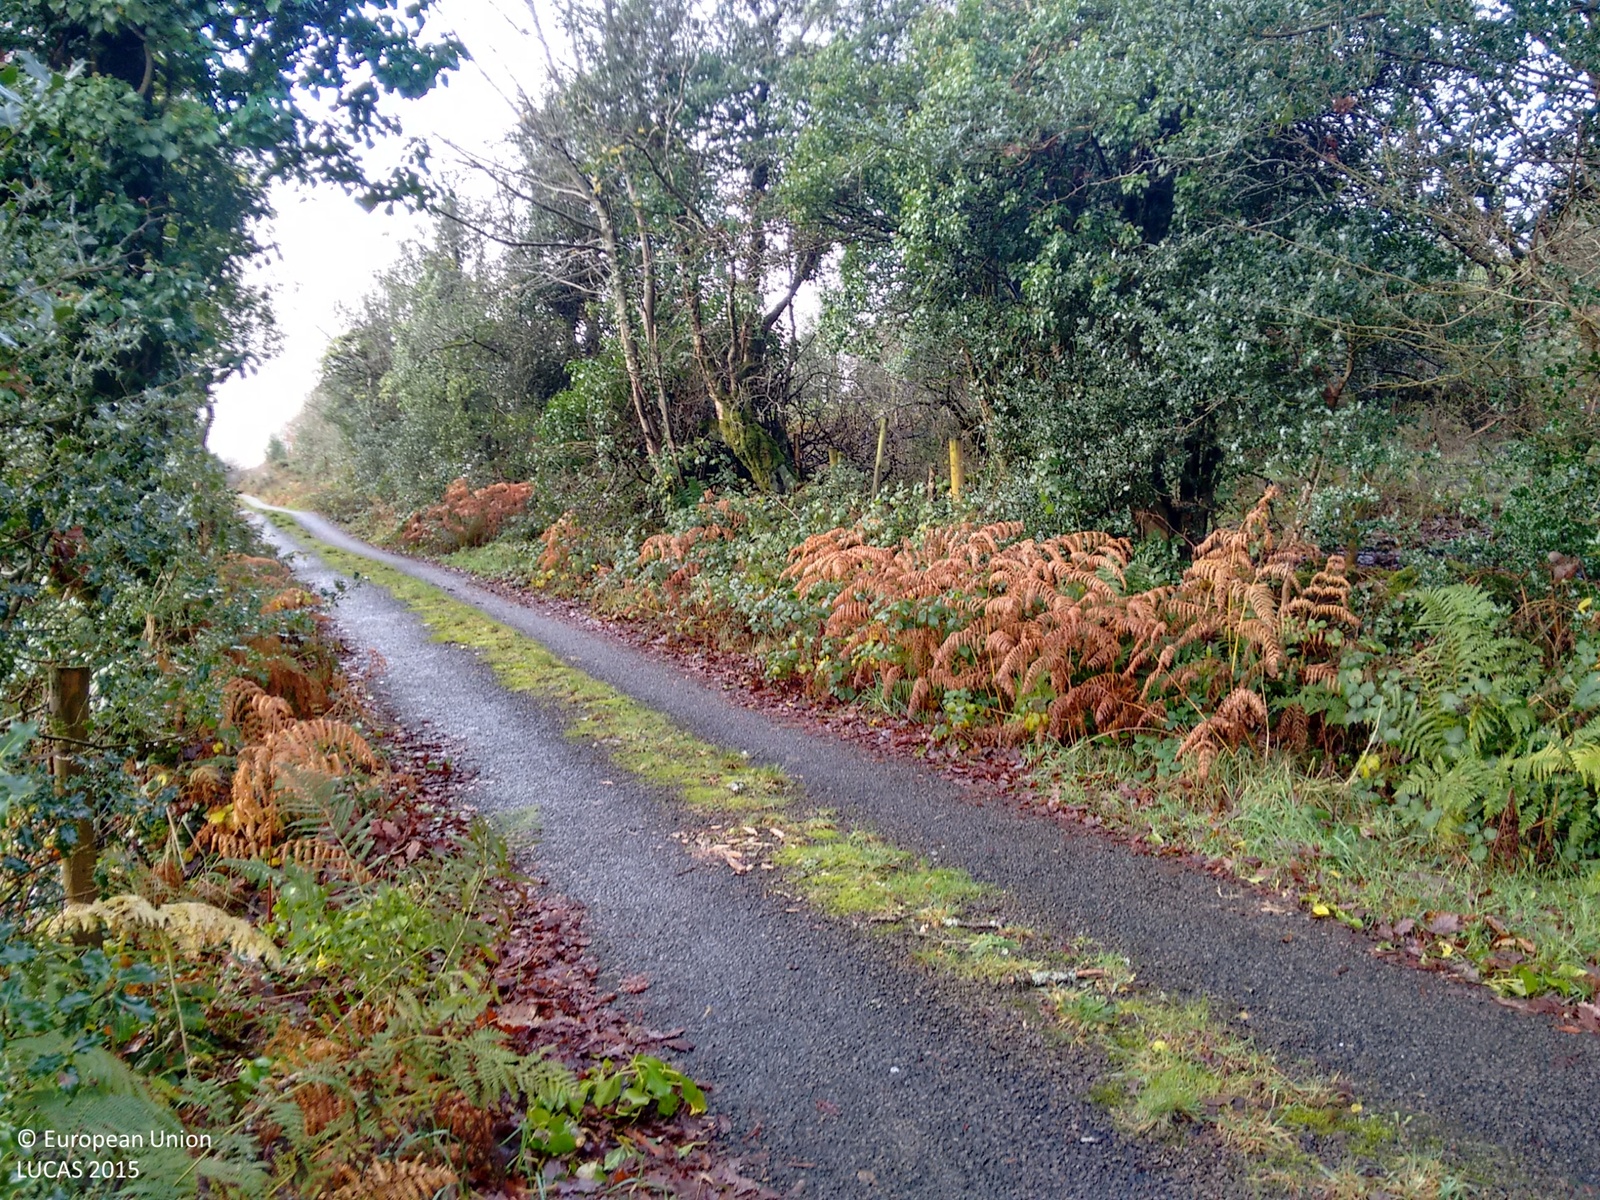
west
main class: Woodland
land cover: Spruce dominated coniferous woodland
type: exotic forest
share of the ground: > 75 %
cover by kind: coniferous forest trees 100 %
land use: Forestry
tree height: > 5 m
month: November
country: IE
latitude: 54.2732
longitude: -8.2254
